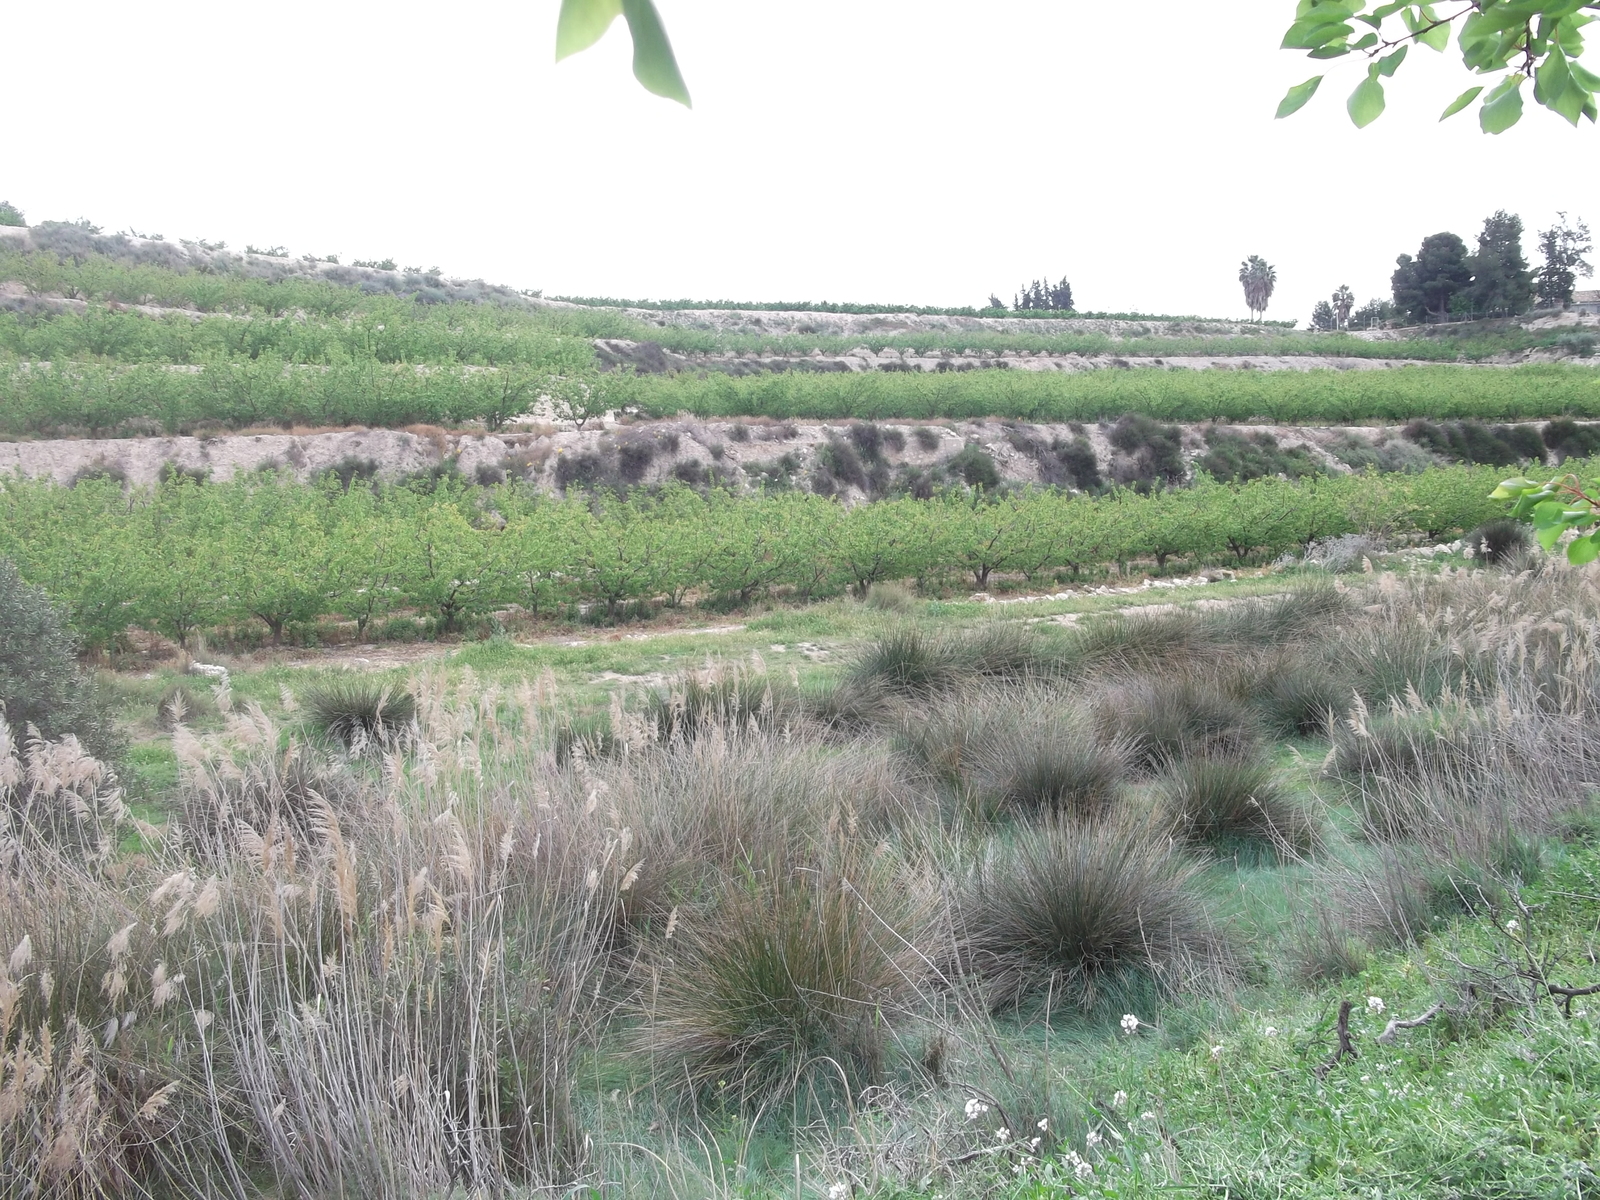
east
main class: Cropland
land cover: Other fruit trees and berries
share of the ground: < 10 %
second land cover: Other bare soil
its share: > 75 %
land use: Agriculture (excluding fallow land and kitchen gardens)
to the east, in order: Other fruit trees and berries; Other bare soil; Shrubland without tree cover; Rivers and streams; Shrubland without tree cover; Pear fruit; Shrubland without tree cover; Pear fruit; Dry stone walls; Pear fruit; Dry stone walls; Pear fruit; Dry stone walls; Pear fruit; Tracks; Dry stone walls; Ditches and canals; Lichens and moss; Pear fruit
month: April
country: ES
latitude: 38.0403
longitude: -1.4601
